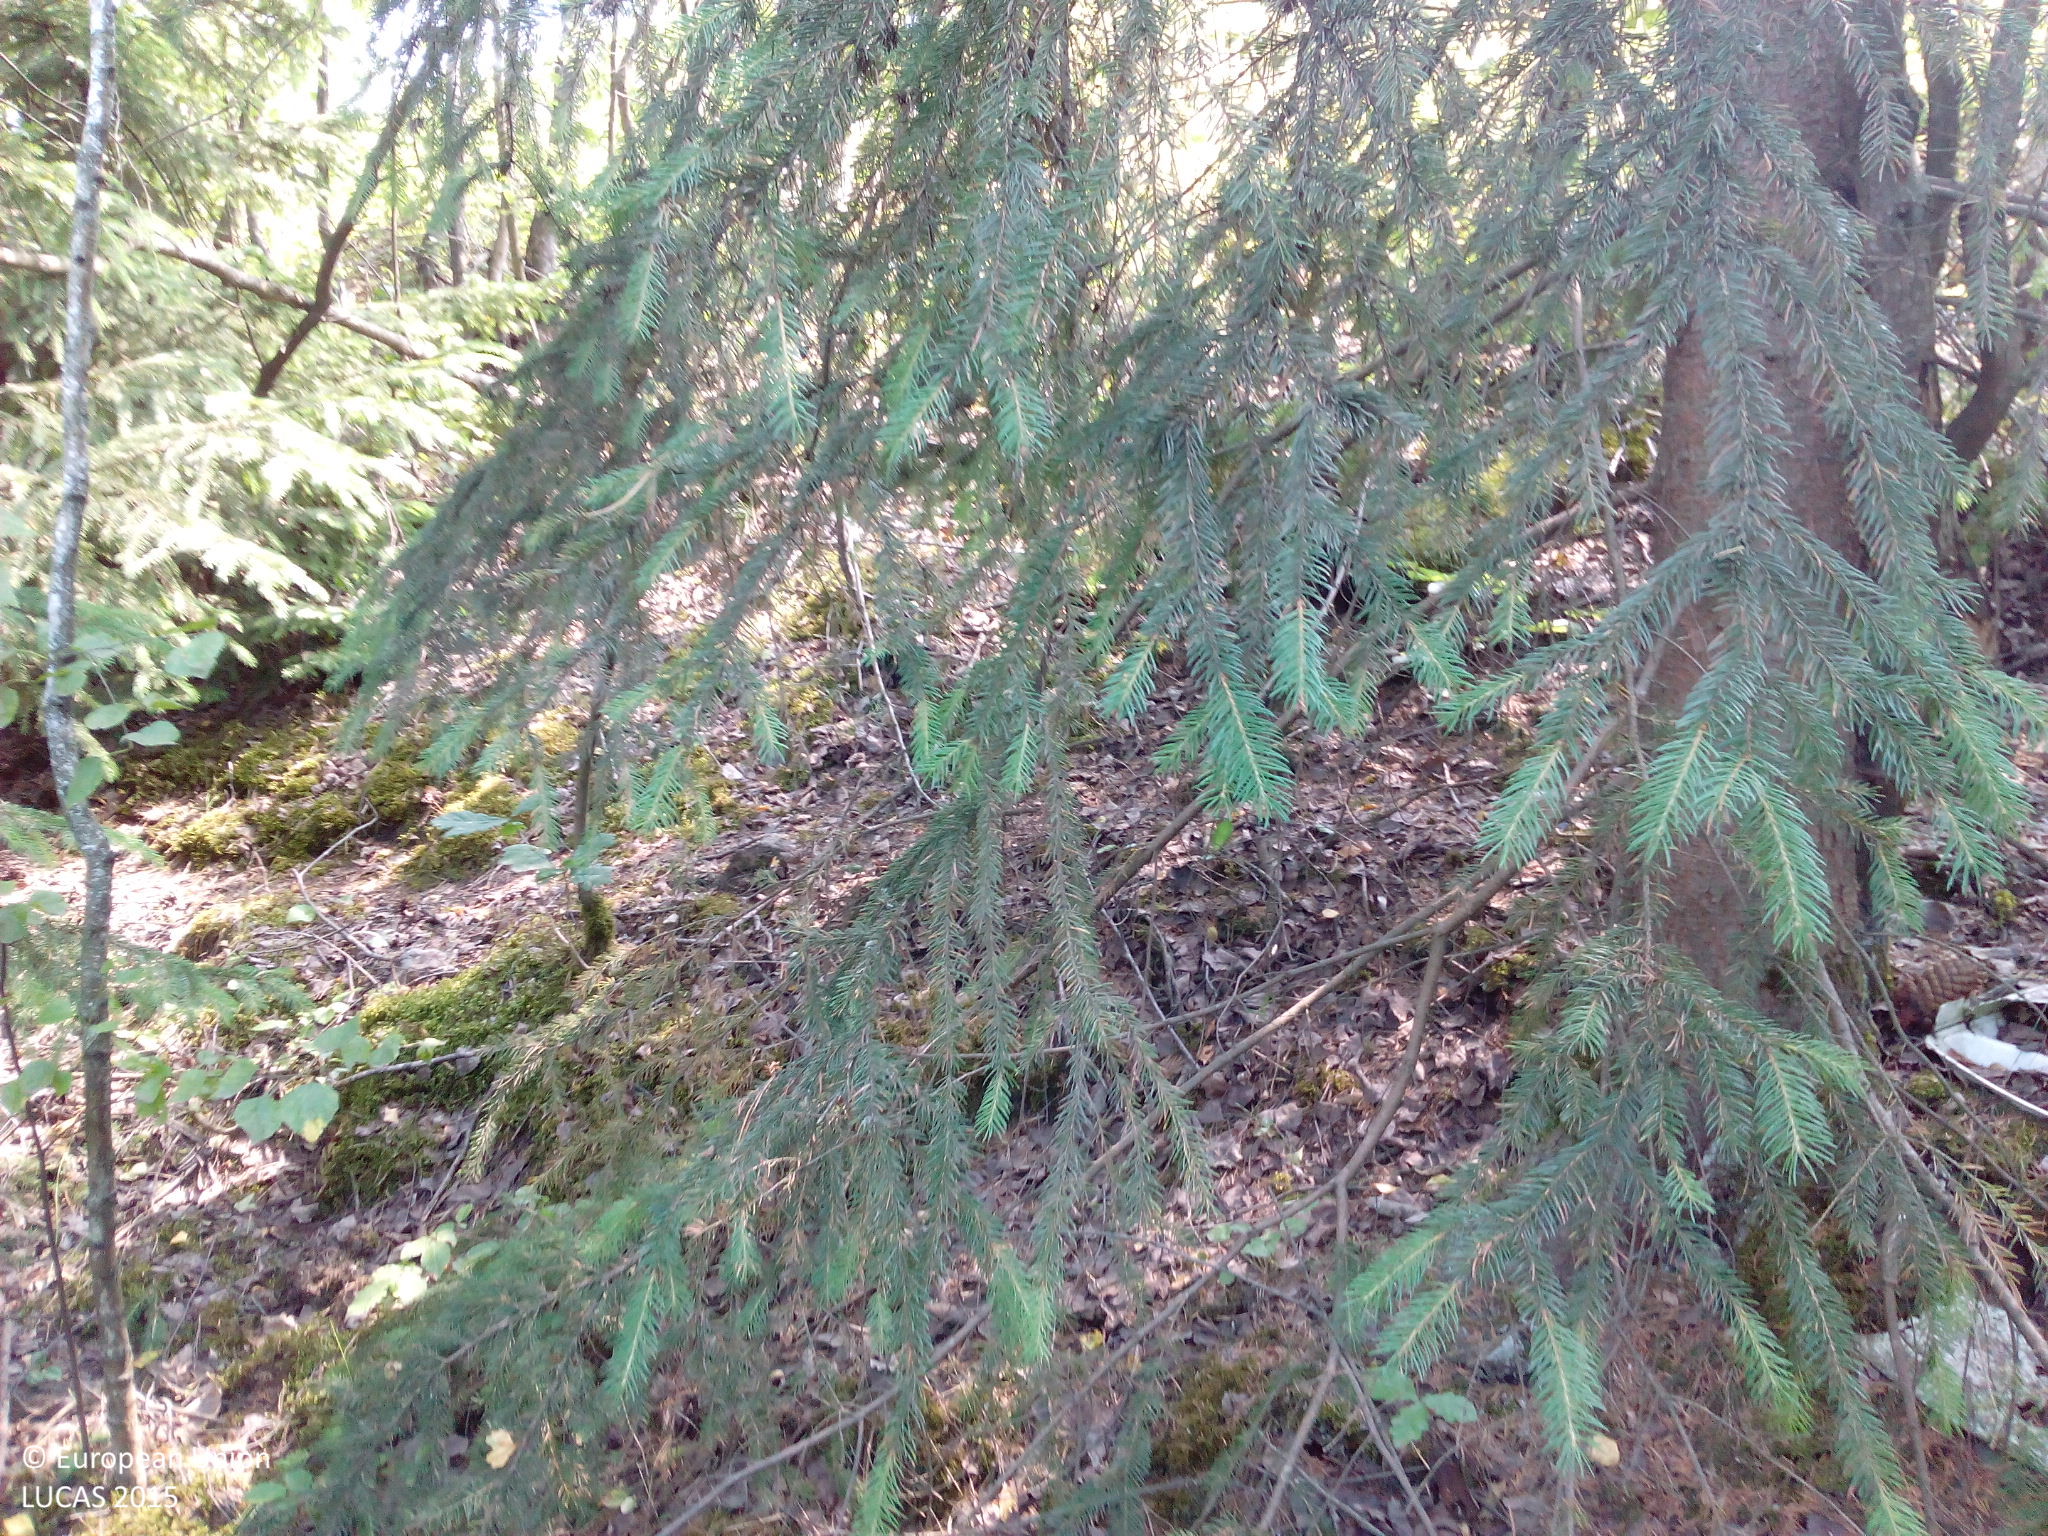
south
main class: Woodland
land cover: Other mixed woodland
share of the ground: > 75 %
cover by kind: coniferous forest trees 75 %, broadleaved forest trees 25 %
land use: Semi-natural and natural areas not in use
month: July
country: DE
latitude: 49.3389
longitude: 7.1515
